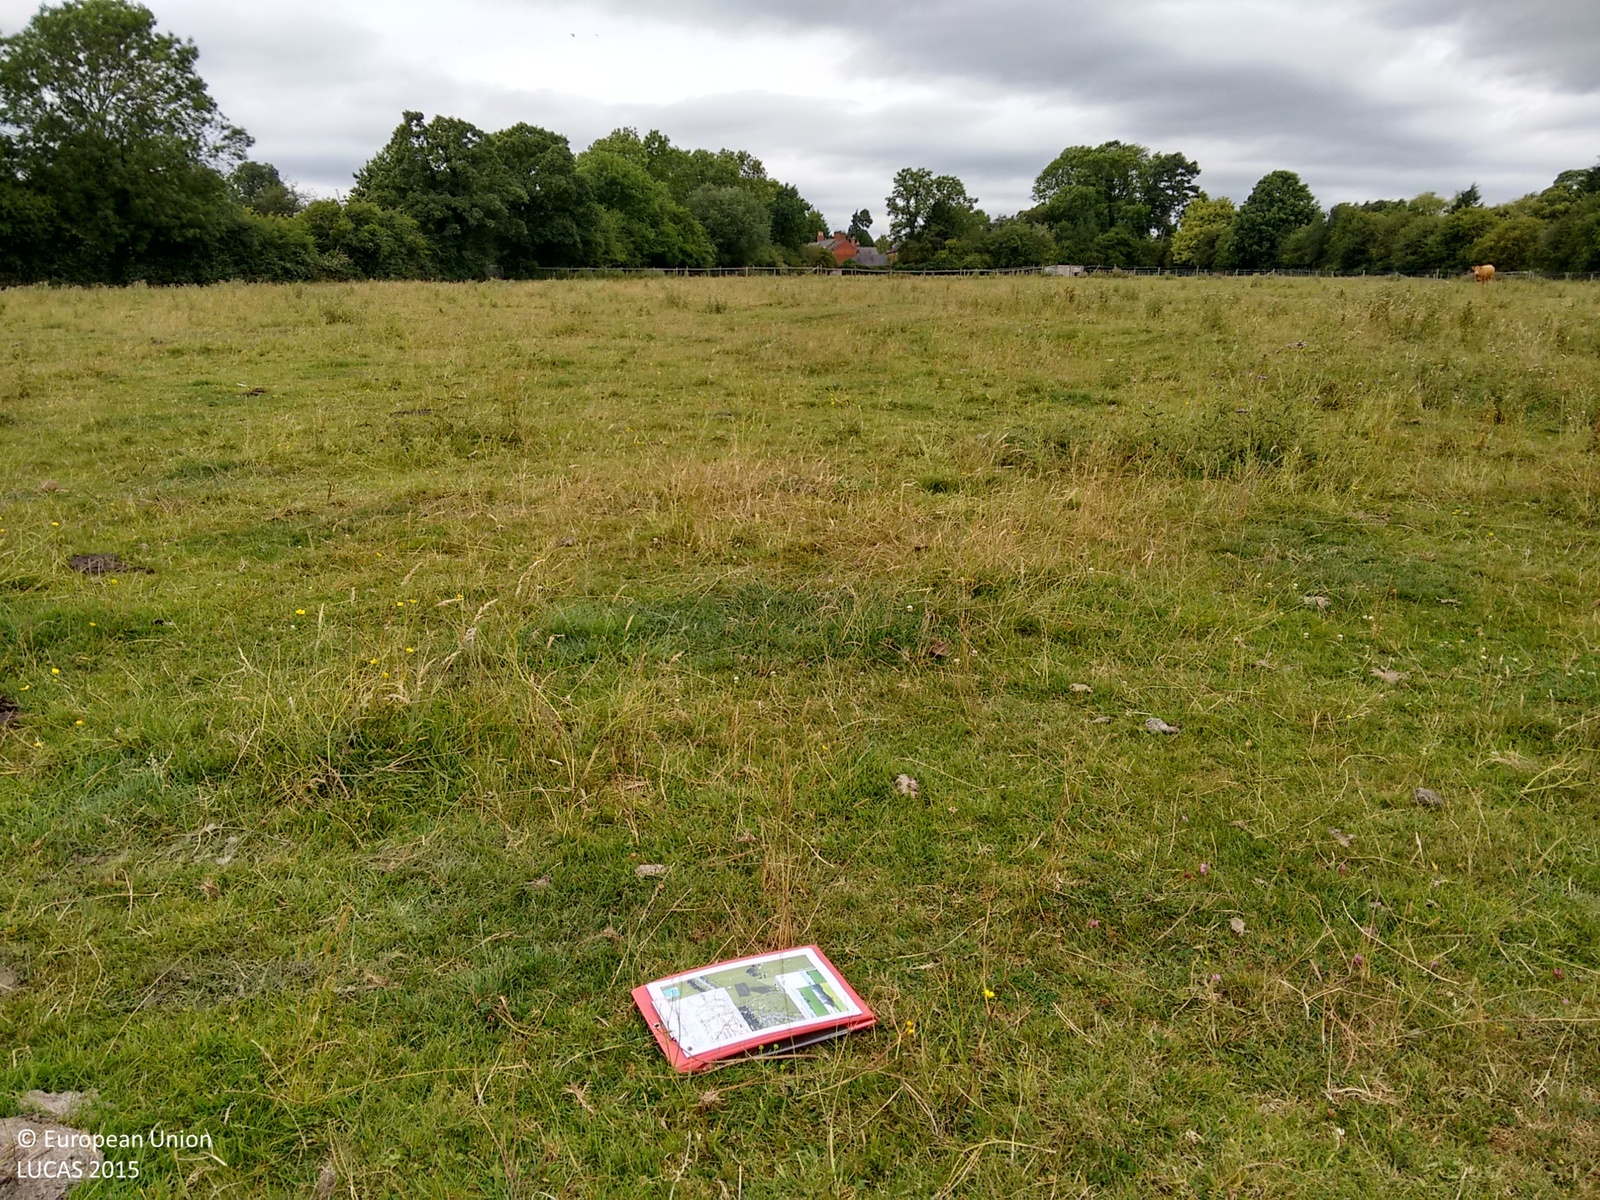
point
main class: Grassland
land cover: Grassland without tree/shrub cover
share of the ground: > 75 %
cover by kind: herbaceous plants 100 %
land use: Agriculture (excluding fallow land and kitchen gardens)
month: July
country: GB
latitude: 52.4912
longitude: -0.8973
